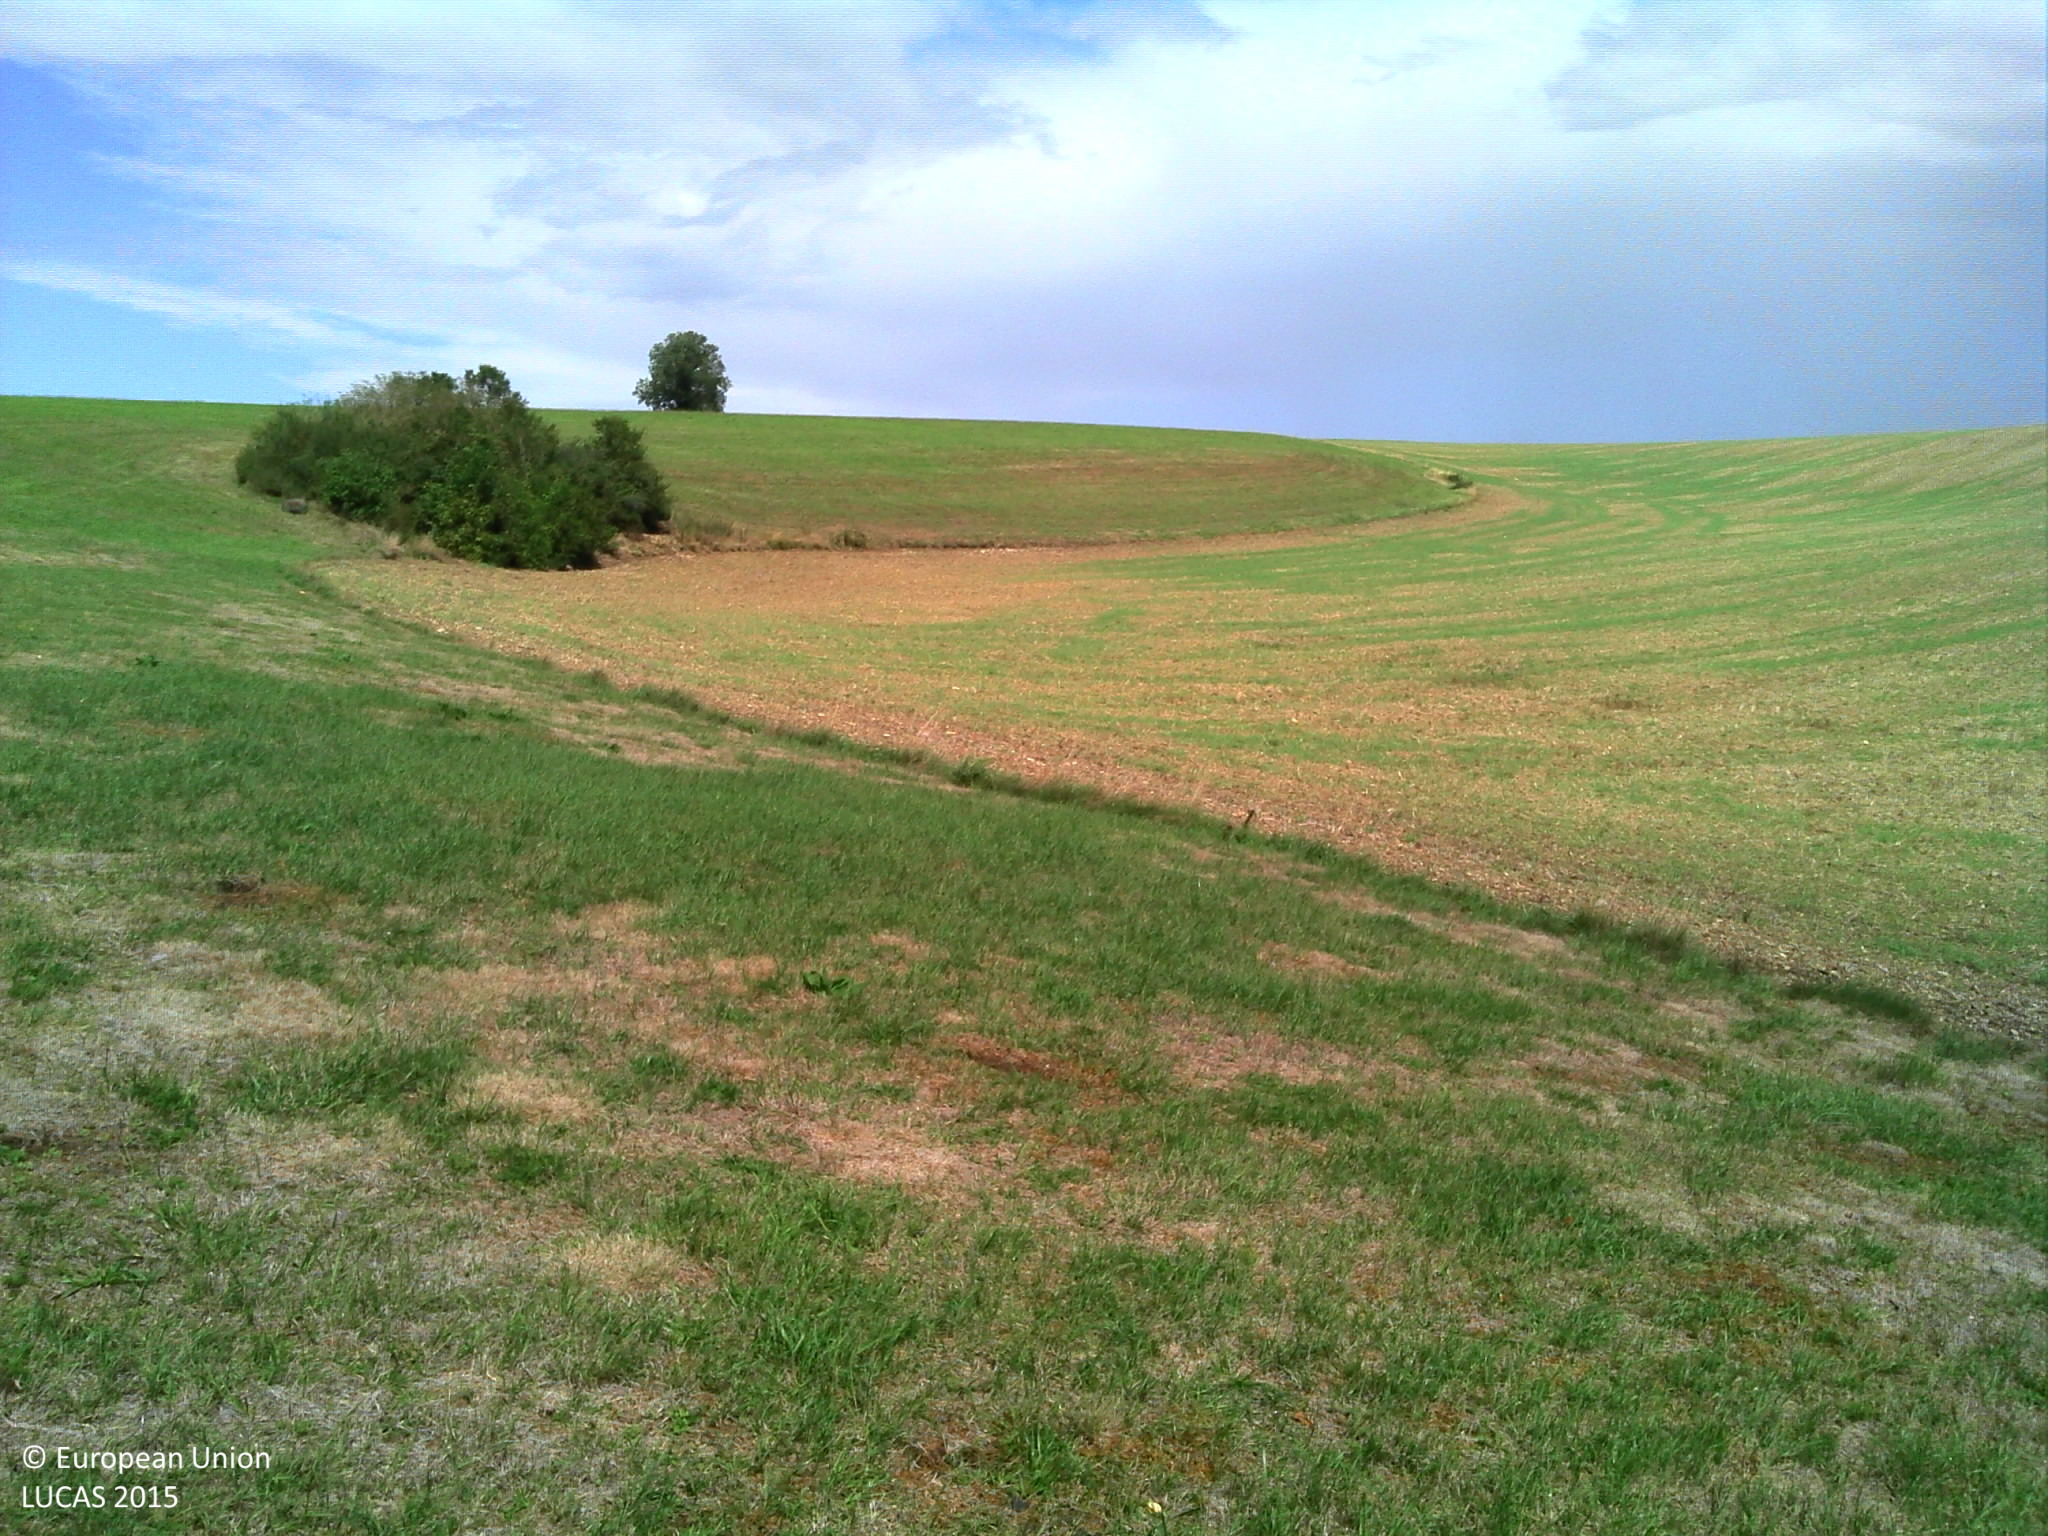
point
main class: Grassland
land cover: Grassland without tree/shrub cover
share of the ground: > 75 %
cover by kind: herbaceous plants 85 %, consolidated bare surface 10 %, lichens and mosses 5 %
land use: Agriculture (excluding fallow land and kitchen gardens)
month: August
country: FR
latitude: 45.3122
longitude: 0.7164
